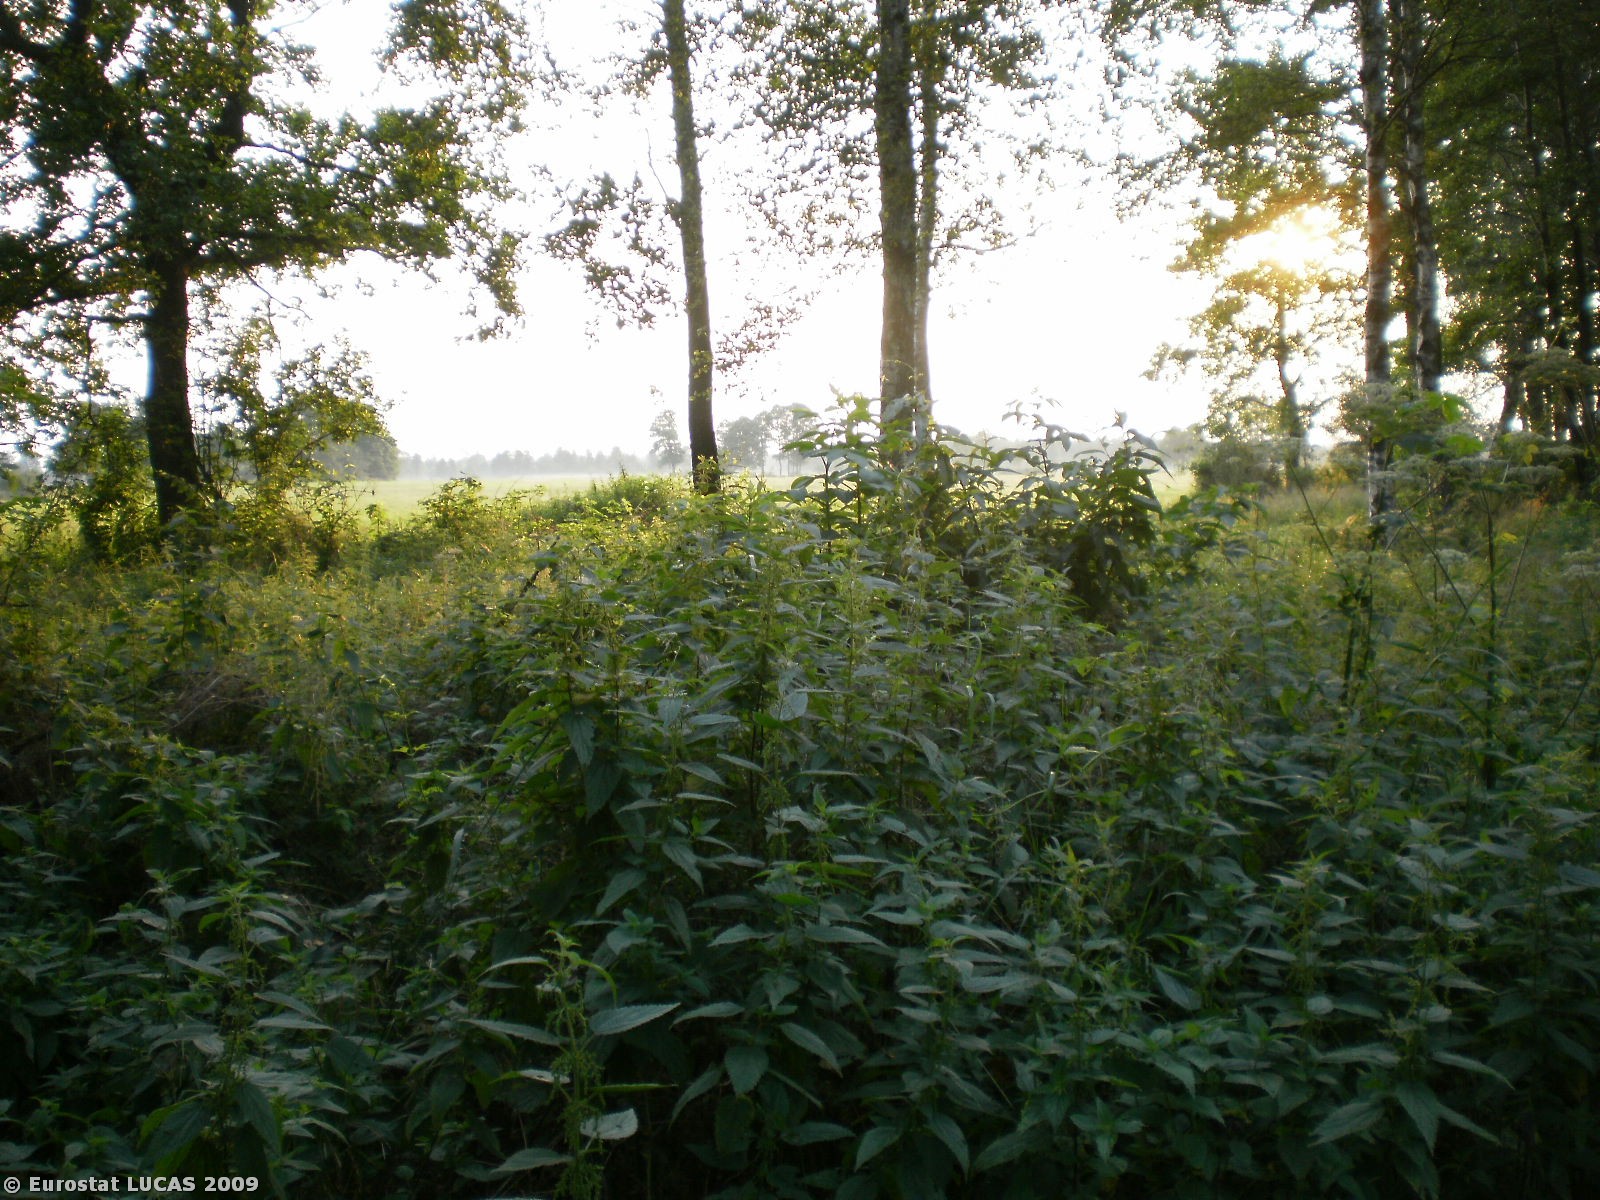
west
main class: Woodland
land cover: Broadleaved woodland
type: mesophytic deciduous forest
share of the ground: 25 - 50 %
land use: Unused
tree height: > 5 m
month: July
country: PL
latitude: 53.4420
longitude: 21.0187
